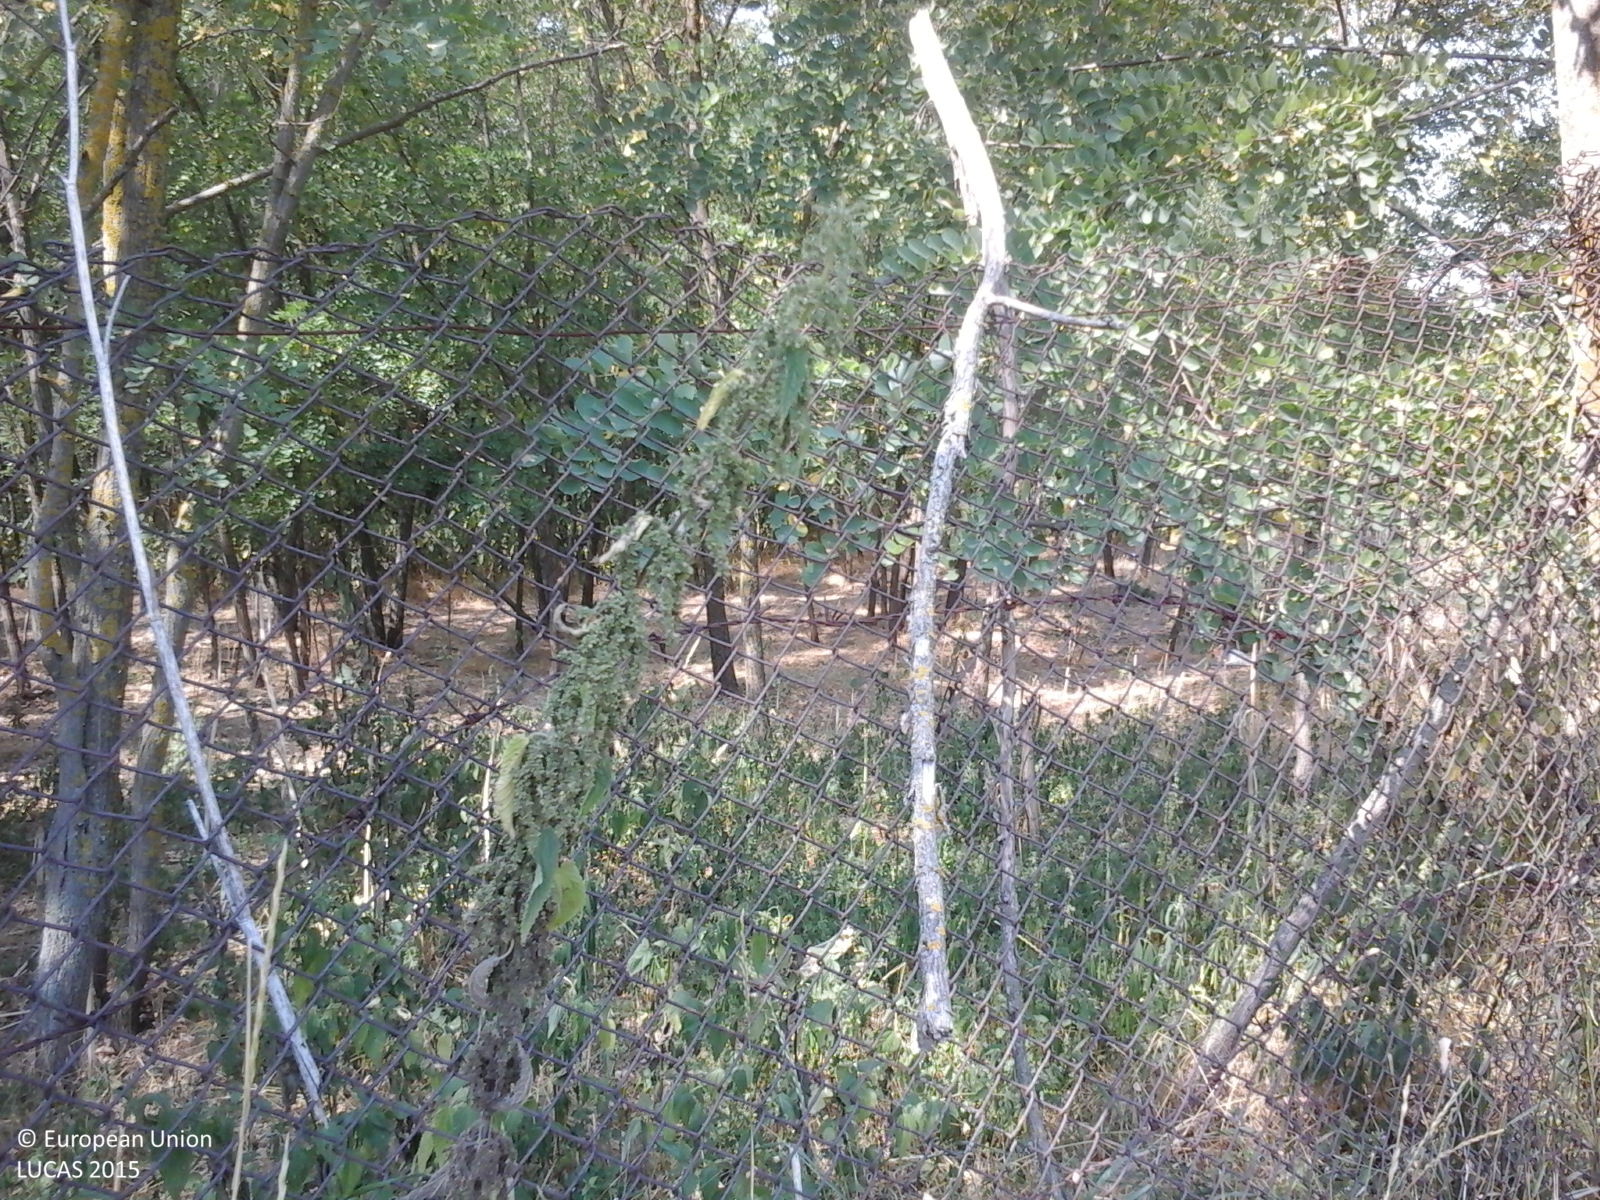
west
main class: Woodland
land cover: Broadleaved woodland
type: exotic forest
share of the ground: > 75 %
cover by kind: broadleaved forest trees 100 %
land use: Forestry
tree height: > 5 m
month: July
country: RO
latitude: 45.5987
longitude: 27.5794
